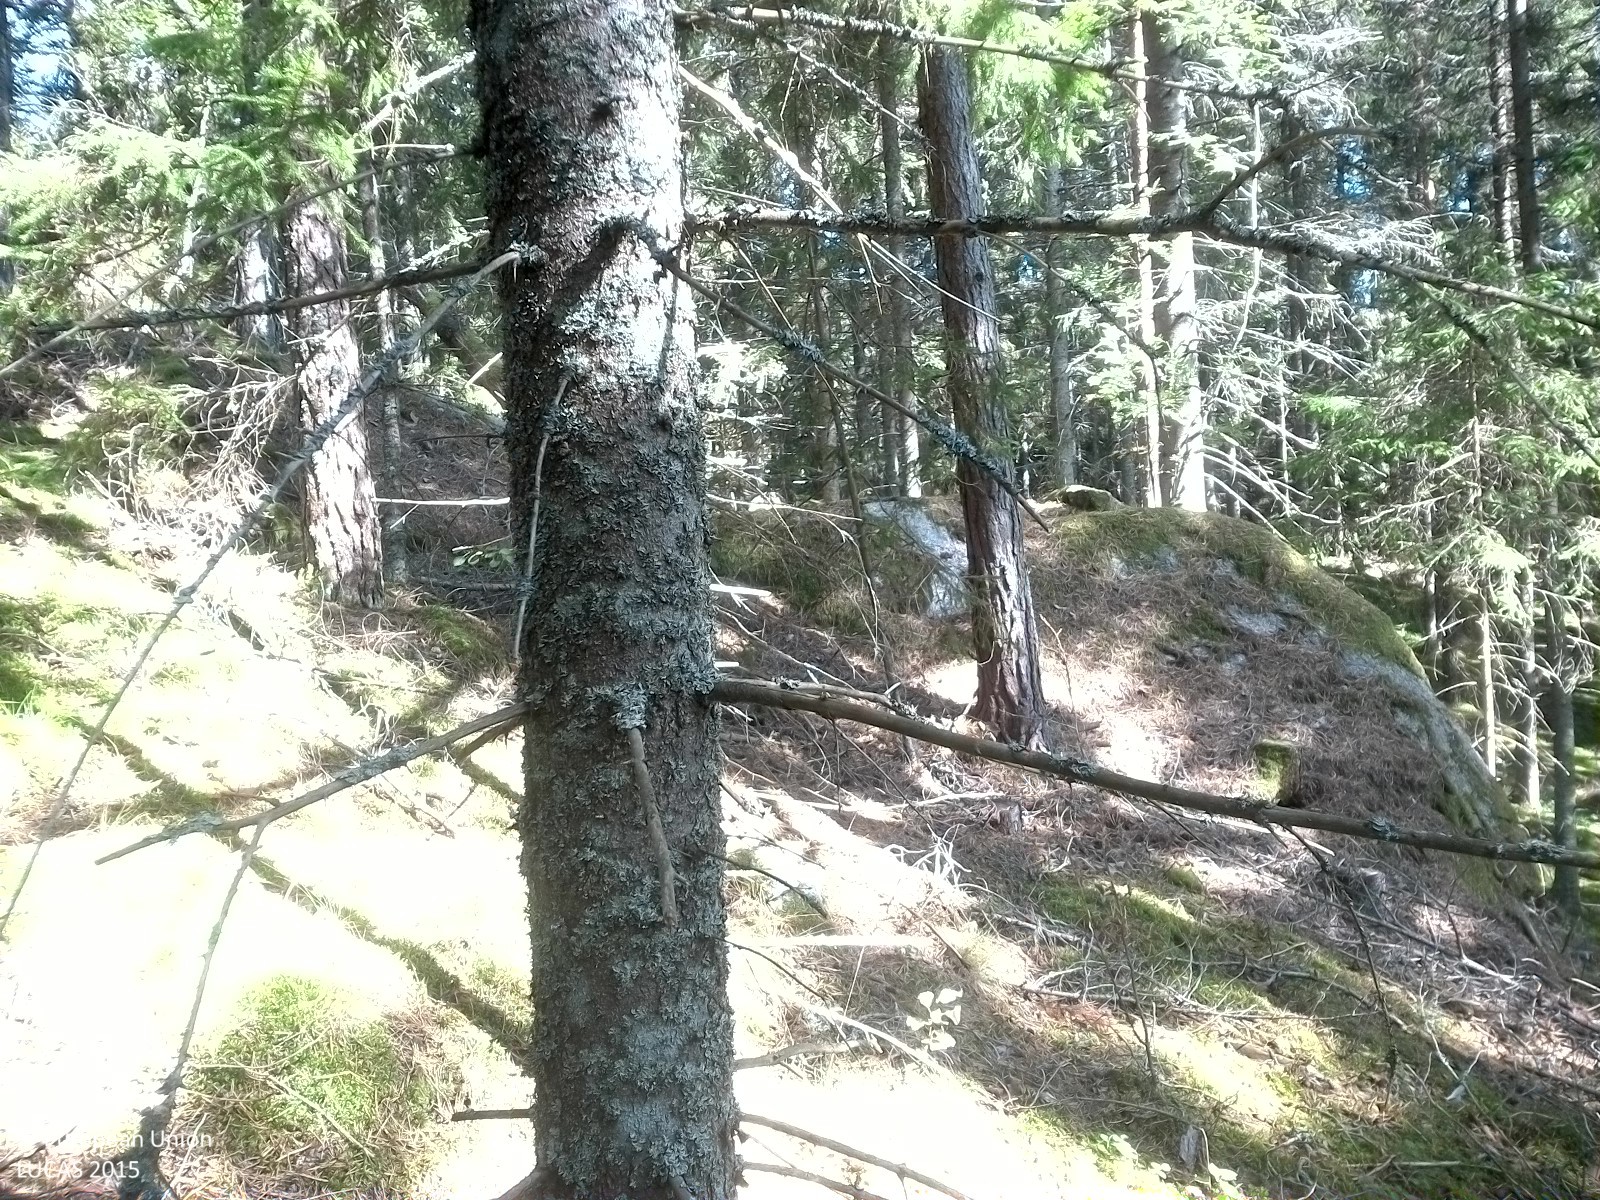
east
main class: Woodland
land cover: Other coniferous woodland
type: boreal forest
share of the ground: 25 - 50 %
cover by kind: coniferous forest trees 40 %, lichens and mosses 30 %, unconsolidated bare surface 20 %, broadleaved forest trees 5 %, herbaceous plants 5 %
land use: Forestry
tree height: > 5 m
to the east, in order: Other coniferous woodland; Spruce dominated coniferous woodland; Pine dominated coniferous woodland; Grassland with sparse tree/shrub cover; Paved roads, cycling and walking lanes; Ditches and canals; Spruce dominated mixed woodland; Electric lines; Spruce dominated mixed woodland; Pine dominated coniferous woodland; Spruce dominated mixed woodland
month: August
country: SE
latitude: 58.6298
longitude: 15.0397
